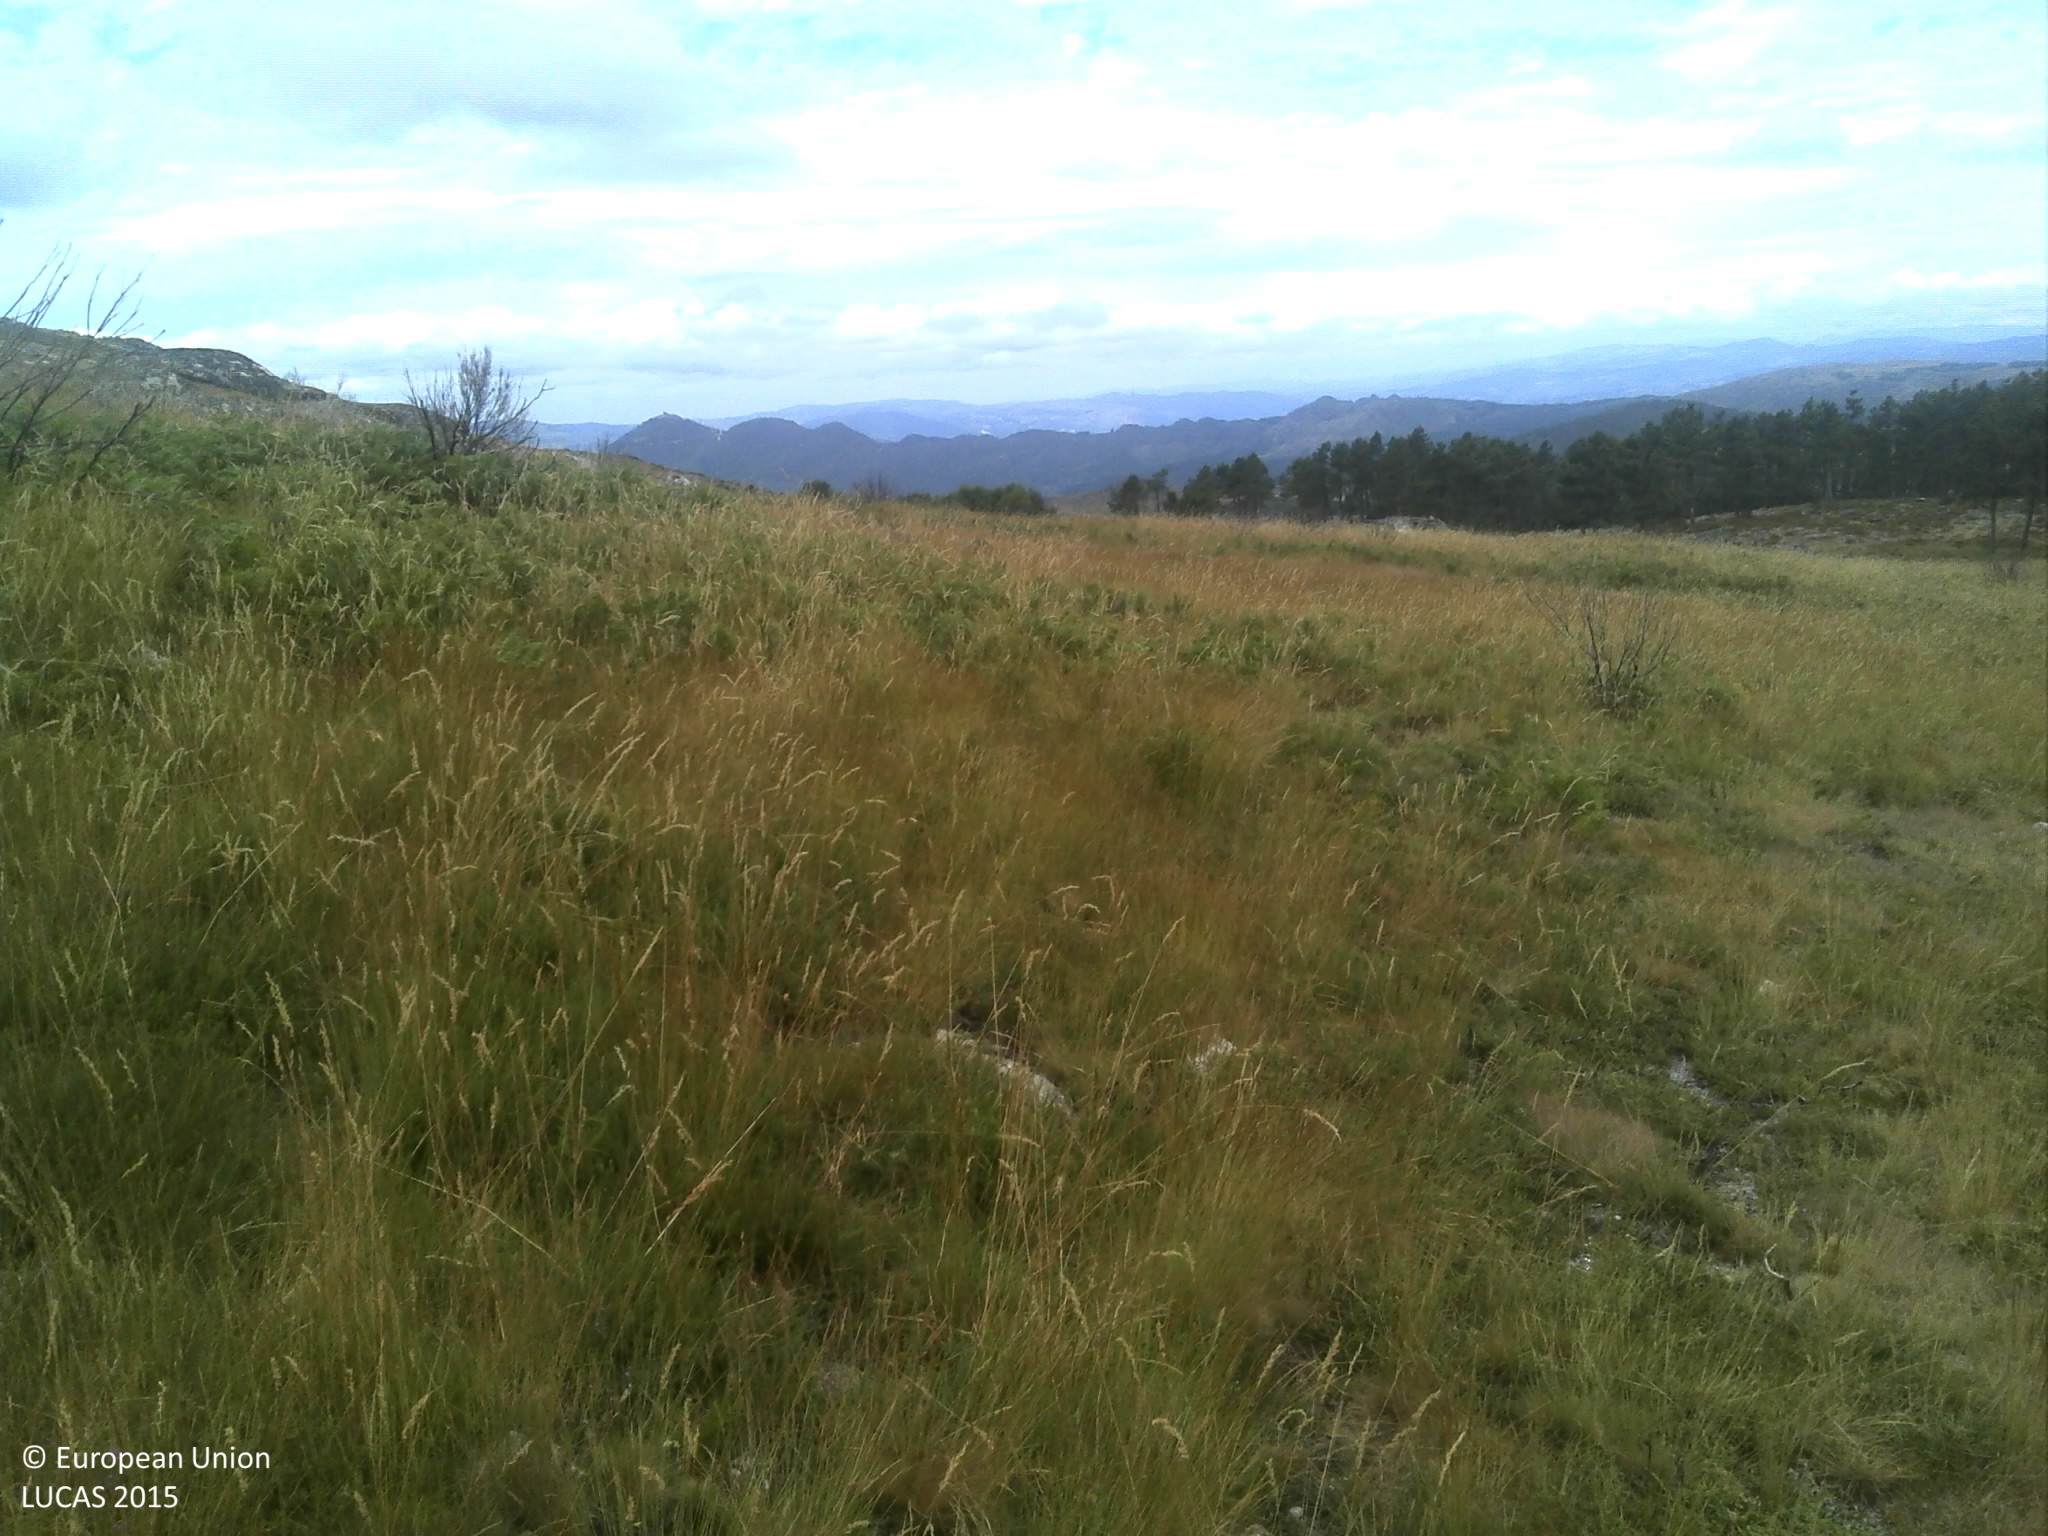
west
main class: Grassland
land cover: Grassland without tree/shrub cover
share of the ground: > 75 %
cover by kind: herbaceous plants 80 %, consolidated bare surface 10 %, shrubs 5 %, unconsolidated bare surface 5 %
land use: Agriculture (excluding fallow land and kitchen gardens)
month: July
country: PT
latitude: 41.3729
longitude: -7.8168
